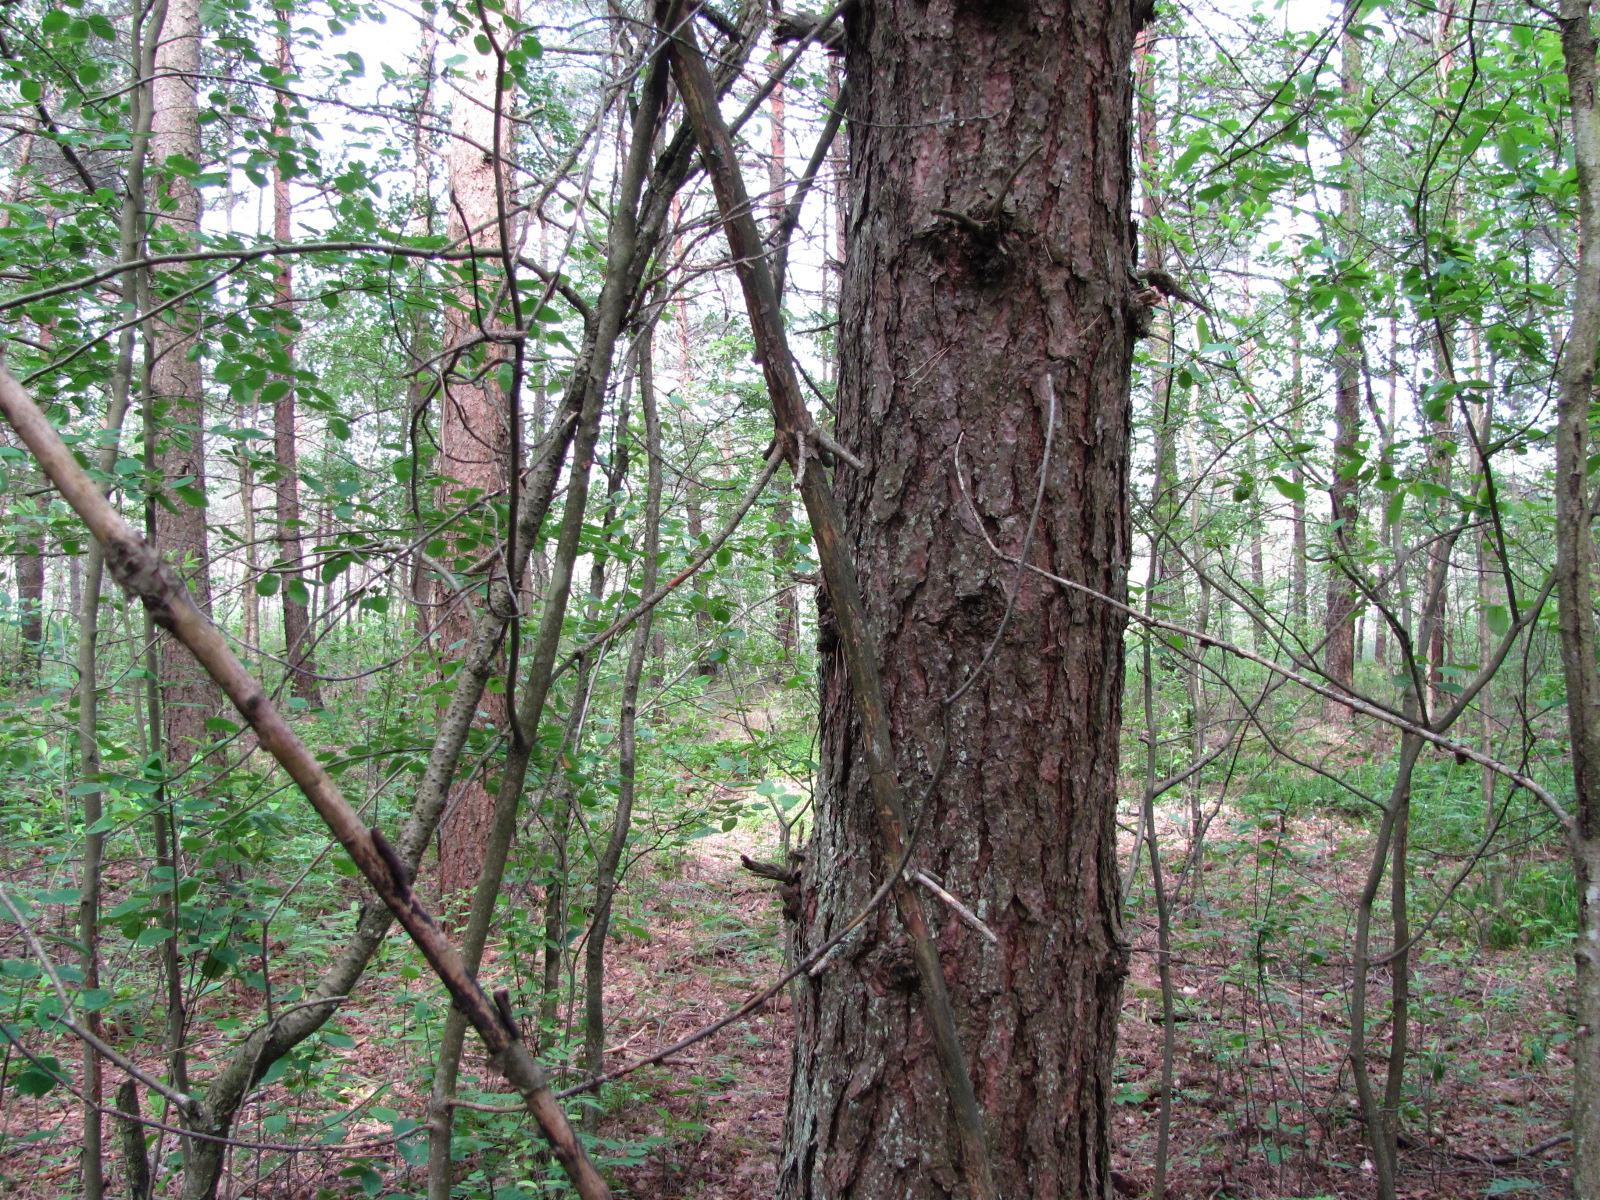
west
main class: Woodland
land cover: Pine dominated mixed woodland
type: mire and swamp forests
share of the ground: > 75 %
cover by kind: coniferous forest trees 70 %, broadleaved forest trees 30 %
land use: Forestry
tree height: > 5 m
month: June
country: LV
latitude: 56.8726
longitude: 23.8789
